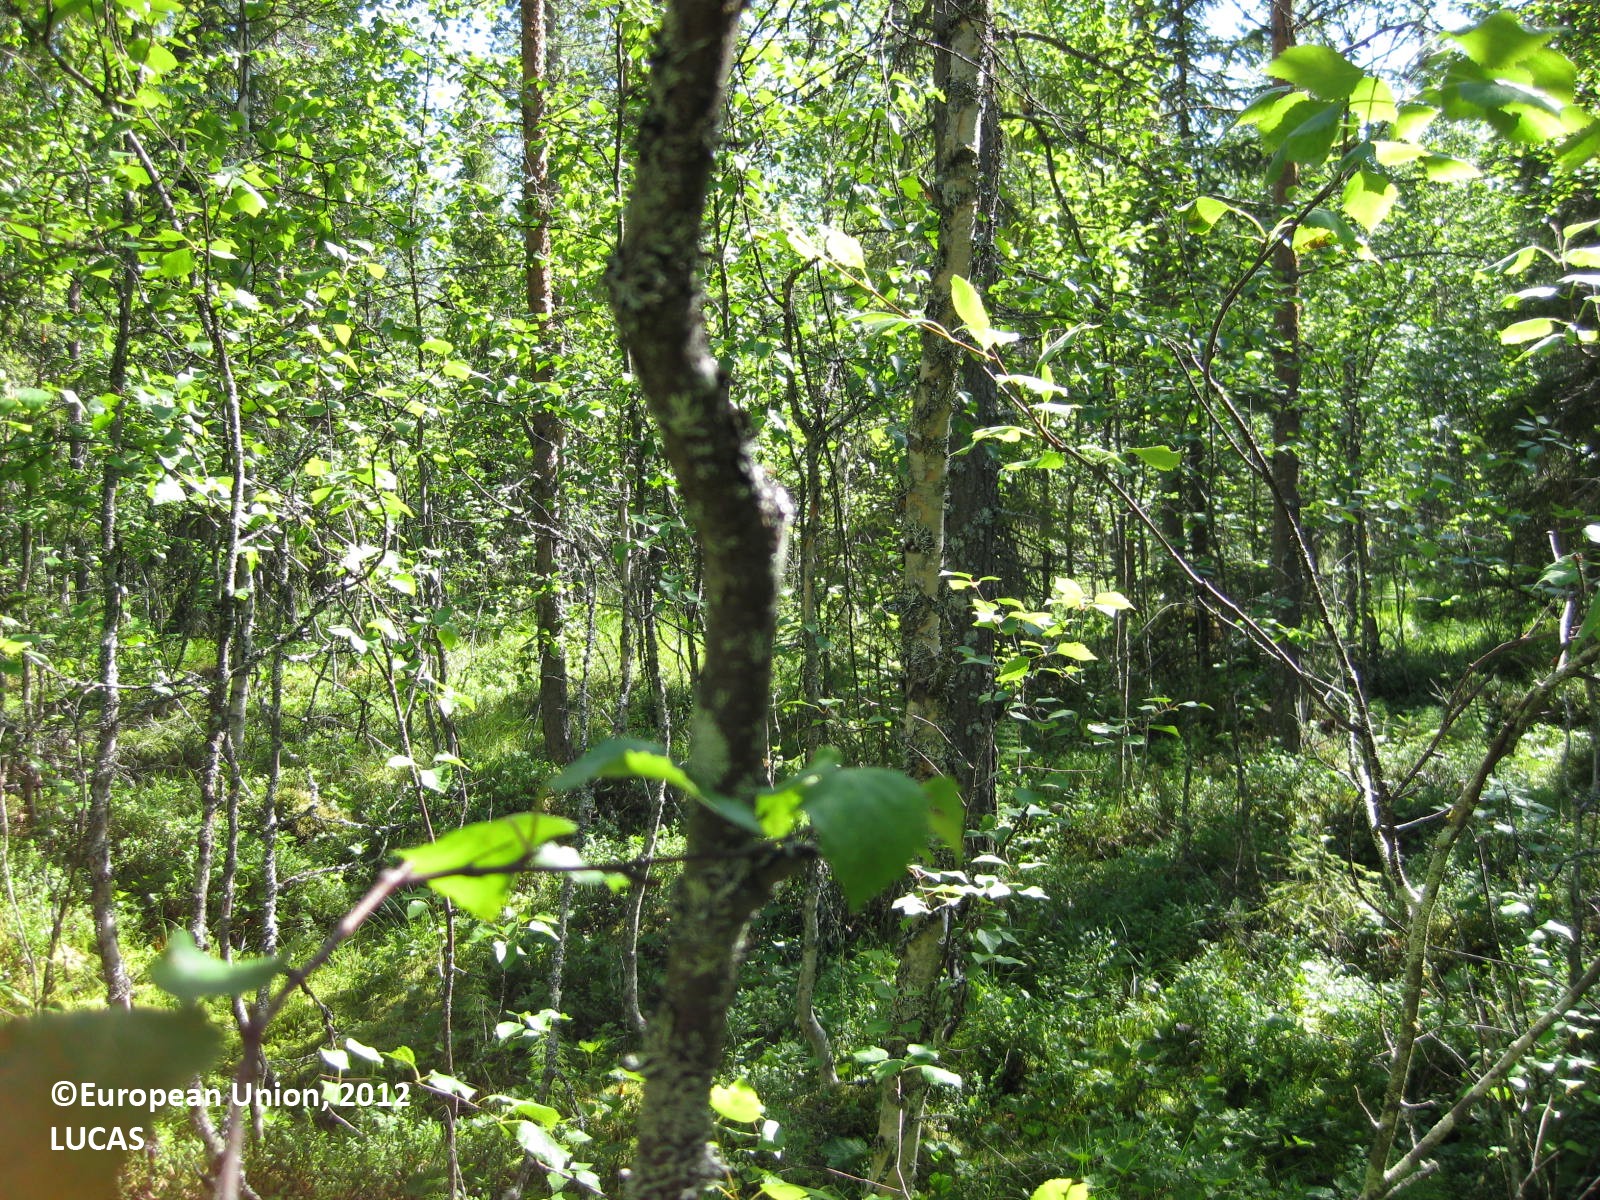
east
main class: Woodland
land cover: Pine dominated mixed woodland
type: boreal forest
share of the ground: > 75 %
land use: Forestry
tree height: > 5 m
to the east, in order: Pine dominated mixed woodland; Ditches and canals; Pine dominated mixed woodland; Other coniferous woodland; Abandoned hedges; Ditches and canals; Abandoned hedges; Pine dominated coniferous woodland; Other mixed woodland; Ditches and canals; Other mixed woodland; Grassland with sparse tree/shrub cover; Ditches and canals; Grassland with sparse tree/shrub cover
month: July
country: FI
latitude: 65.6121
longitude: 28.5000
